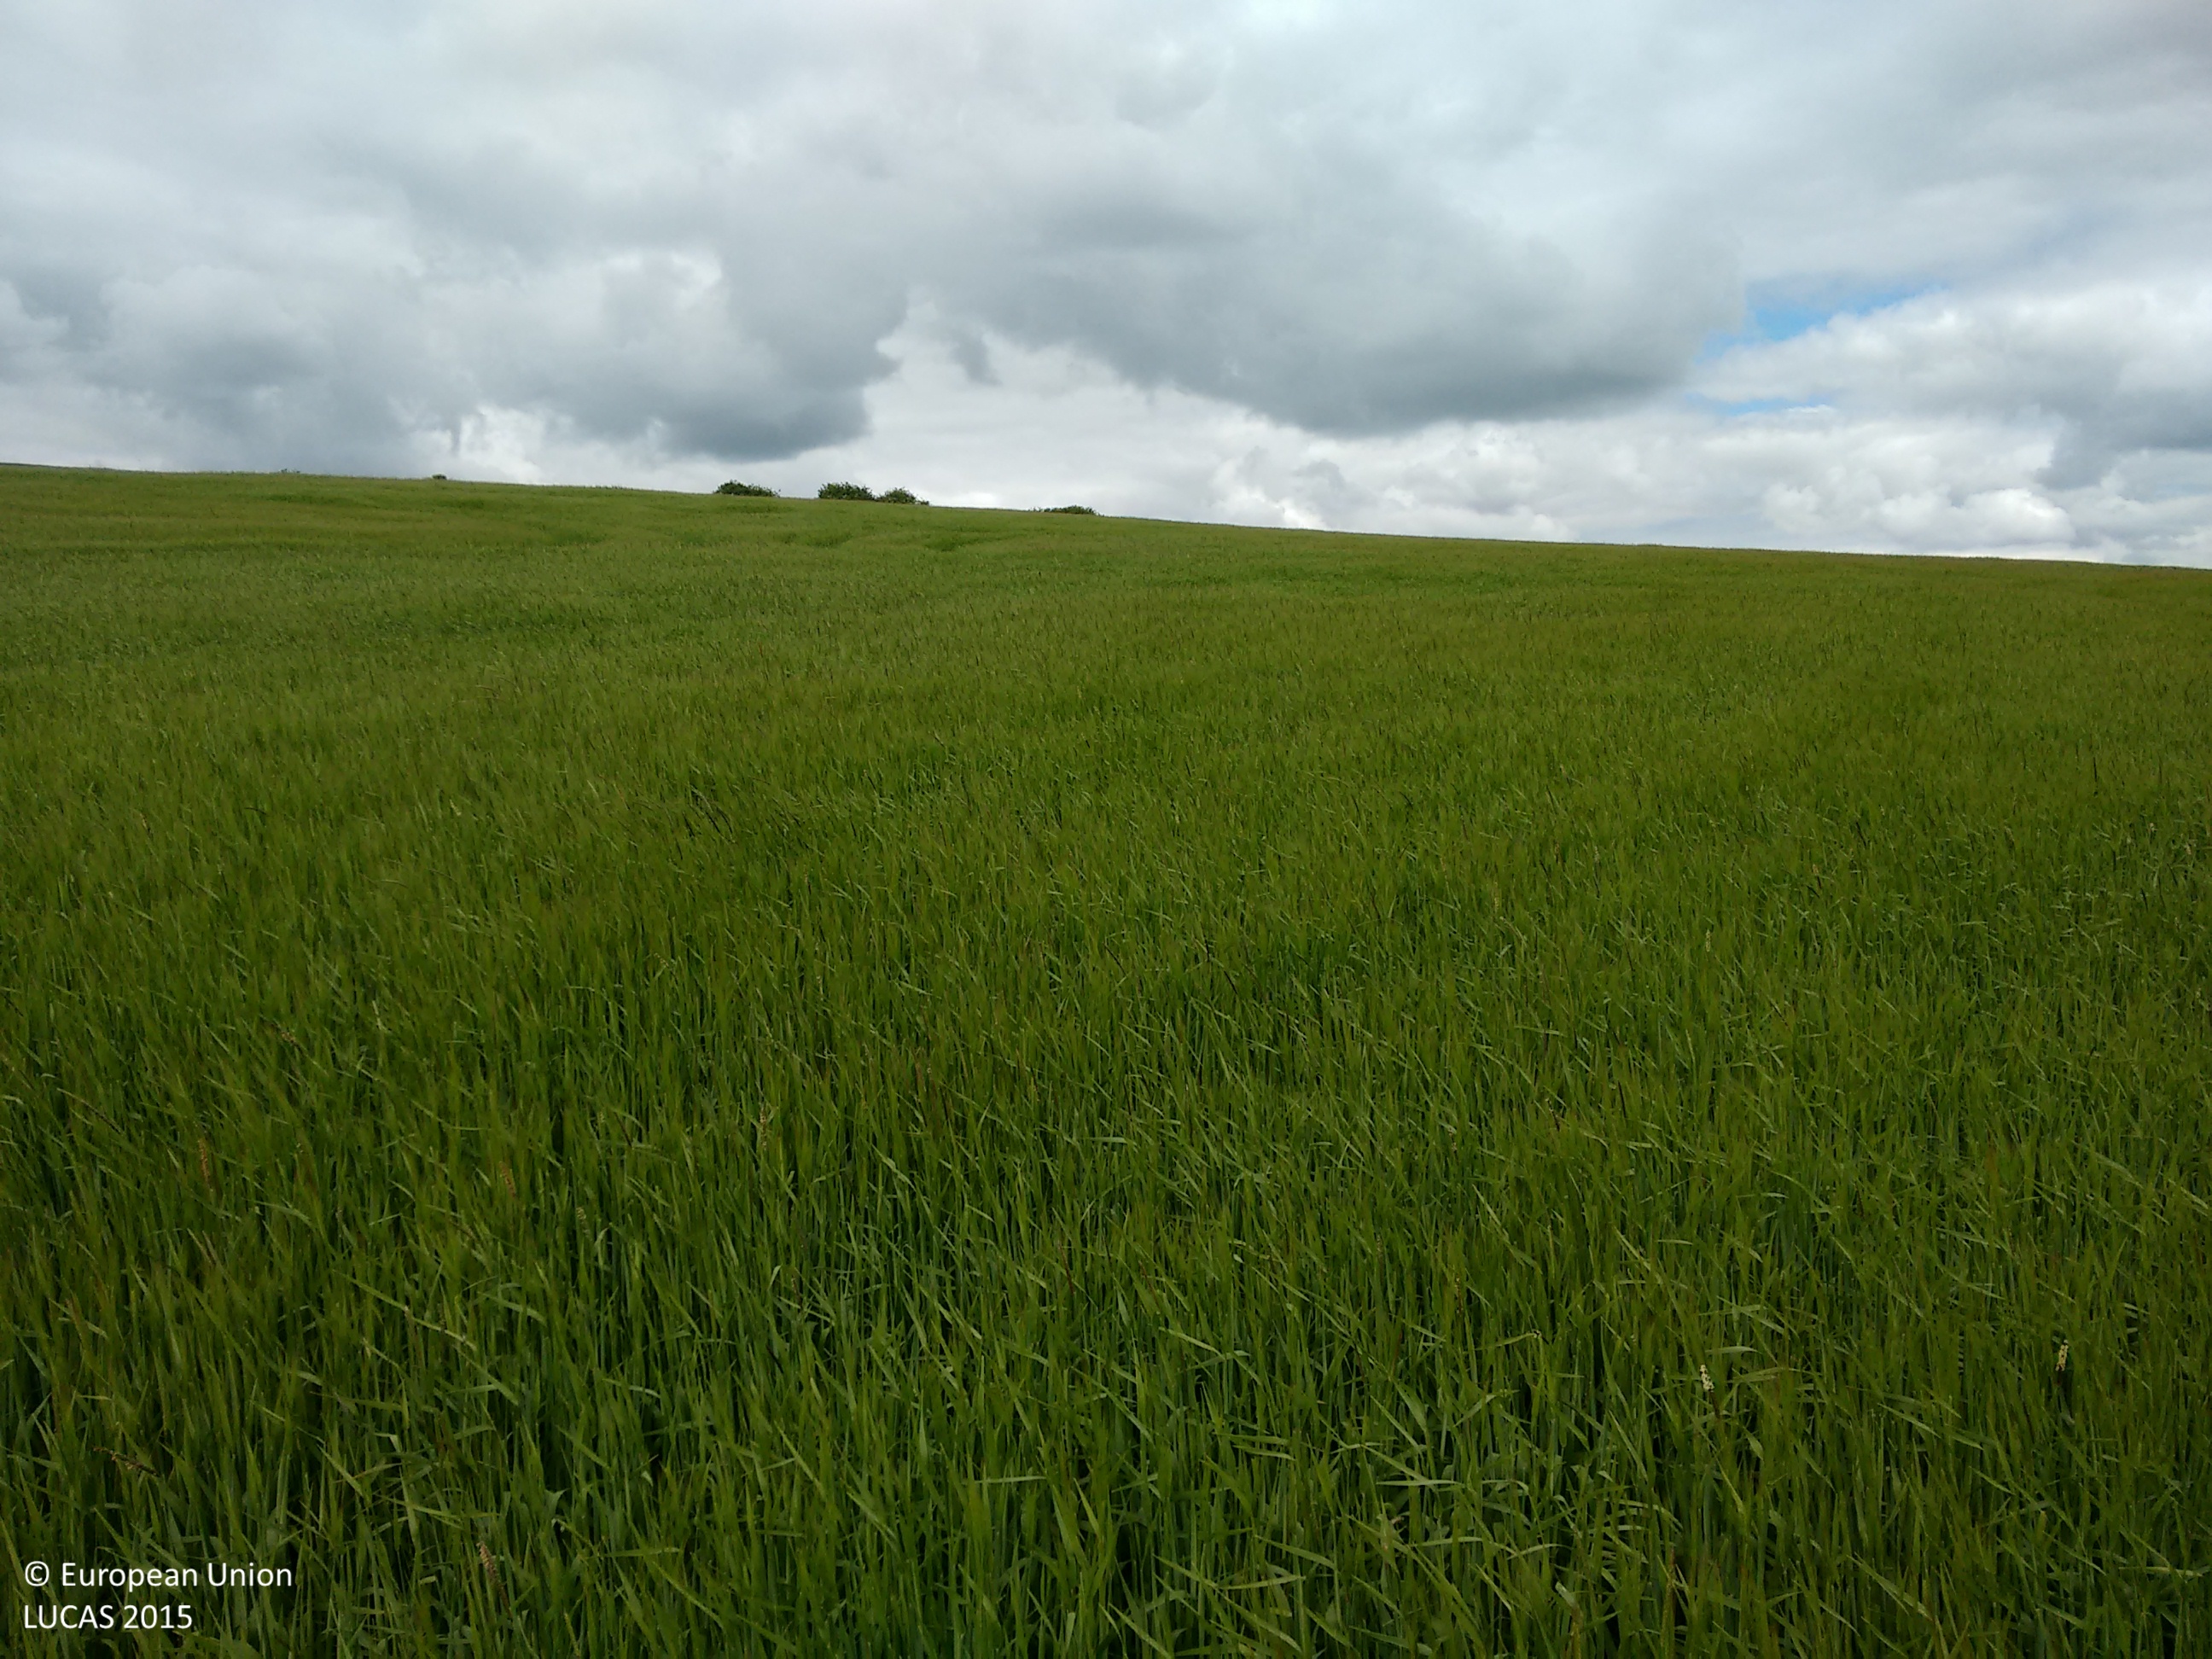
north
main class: Cropland
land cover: Barley
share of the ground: > 75 %
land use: Agriculture (excluding fallow land and kitchen gardens)
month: June
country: GB
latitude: 51.1188
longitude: -1.9293
